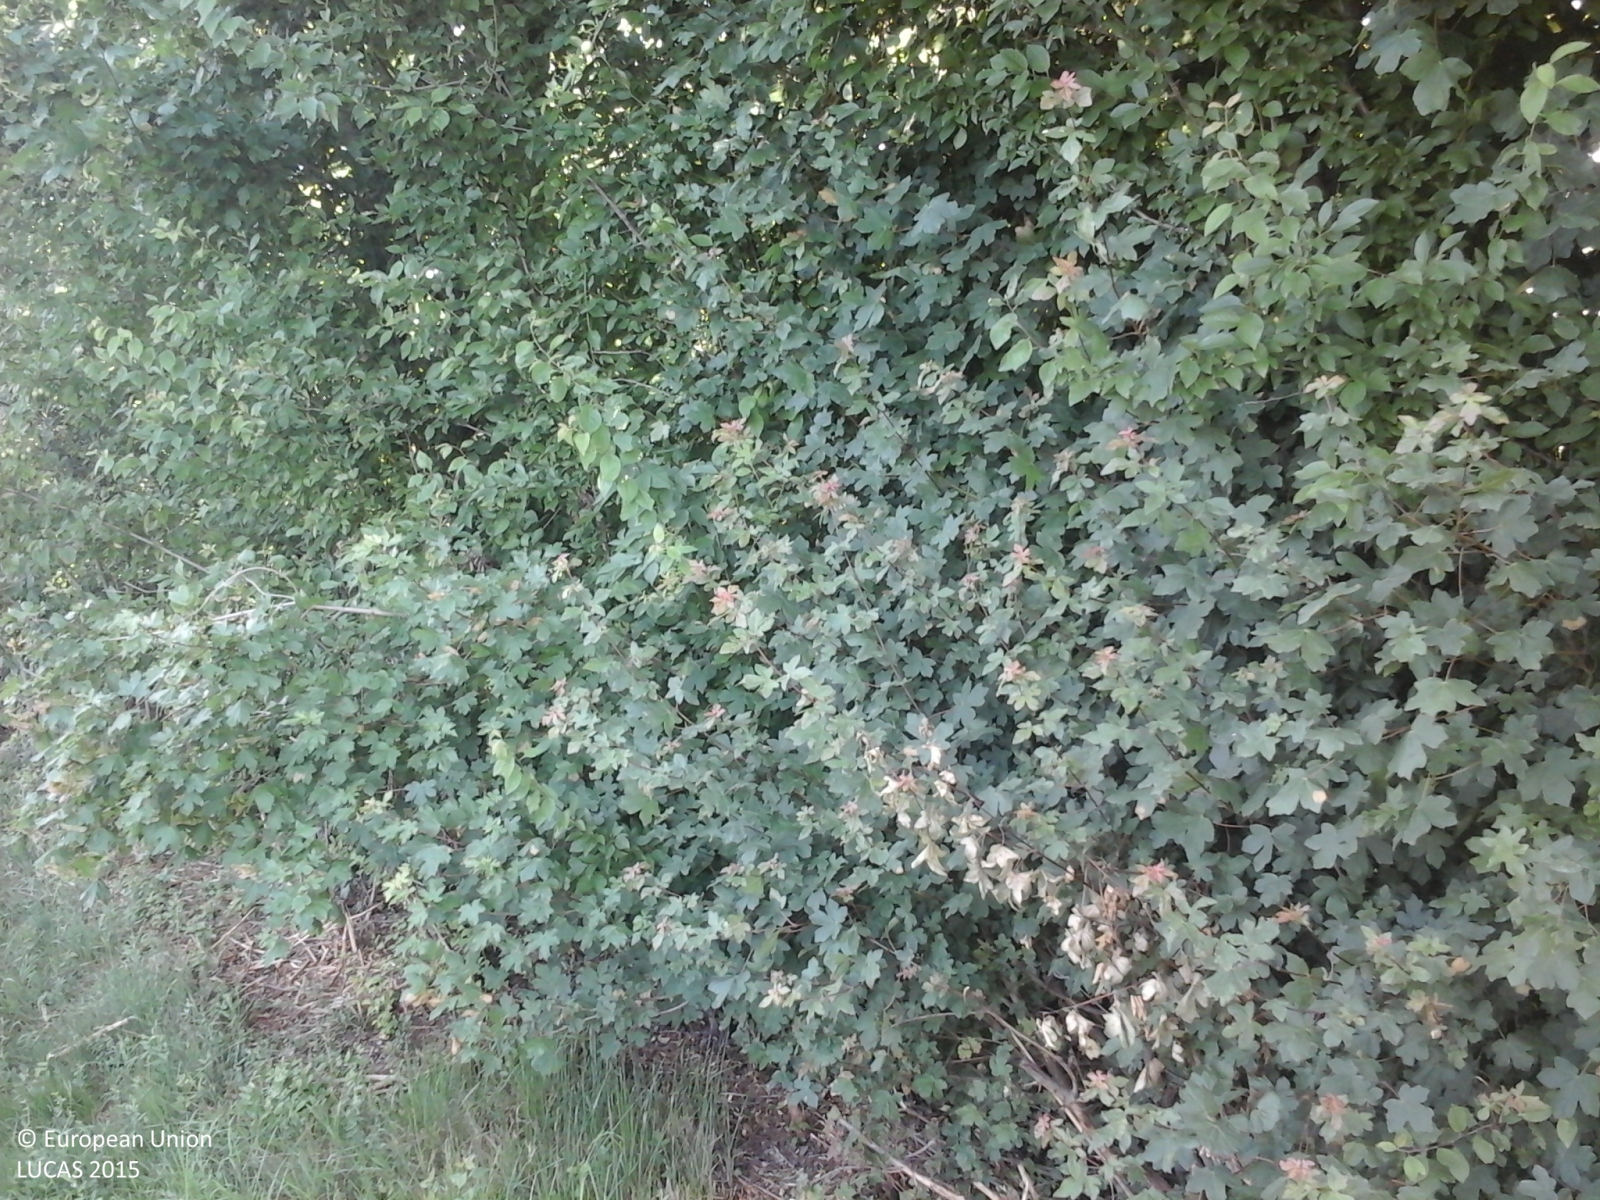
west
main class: Cropland
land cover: Lucerne
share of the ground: > 75 %
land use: Agriculture (excluding fallow land and kitchen gardens)
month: May
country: IT
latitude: 45.1048
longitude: 10.7991
